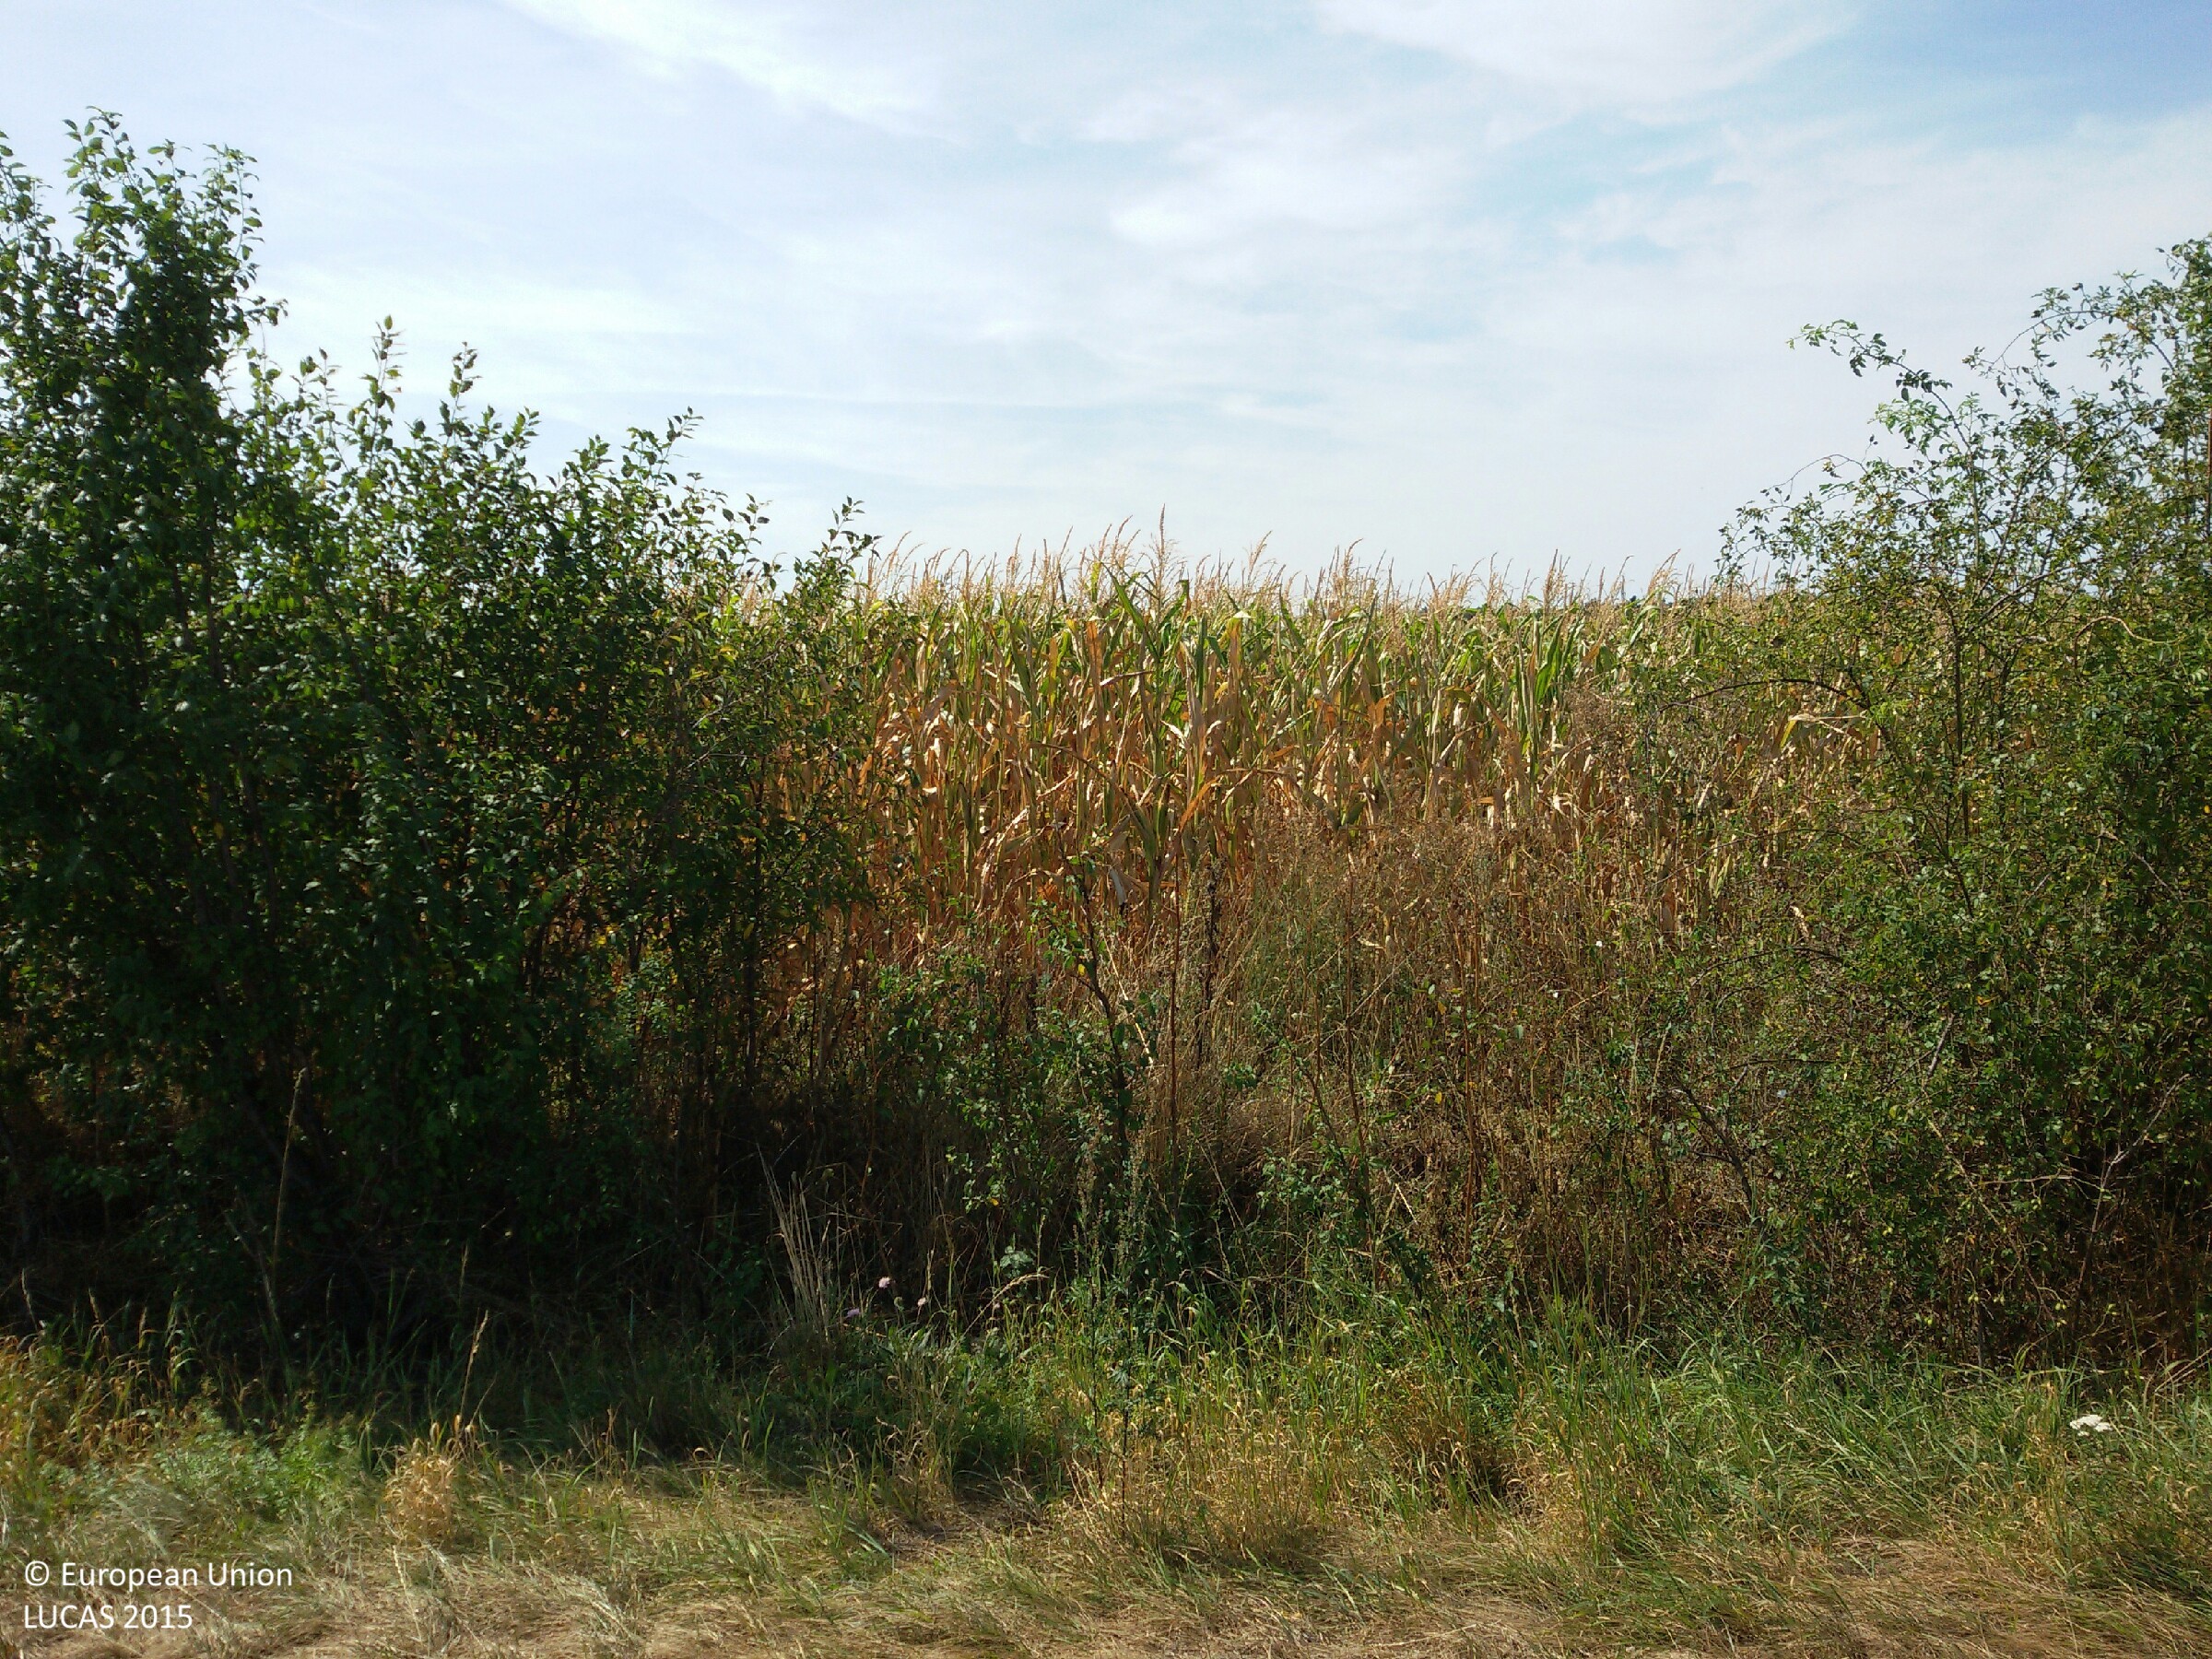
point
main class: Cropland
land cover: Maize
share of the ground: > 75 %
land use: Agriculture (excluding fallow land and kitchen gardens)
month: August
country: PL
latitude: 52.4264
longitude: 14.7522
